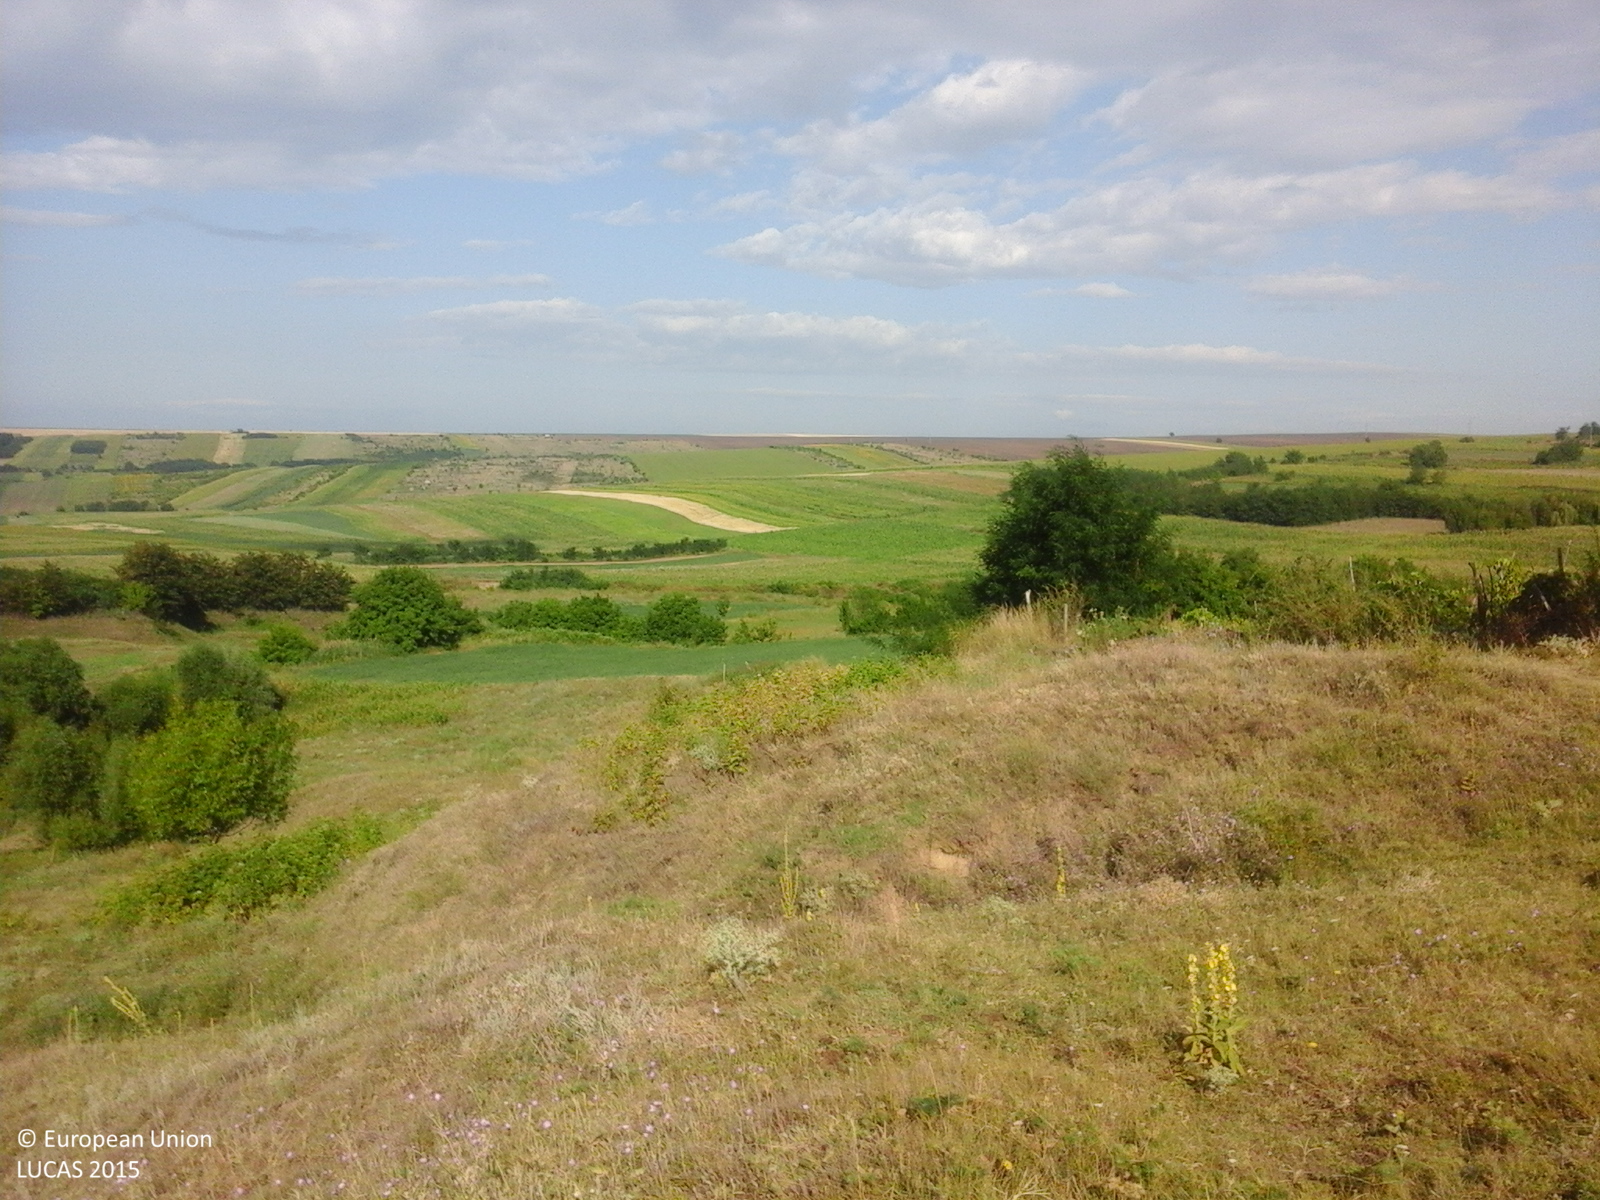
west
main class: Grassland
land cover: Grassland without tree/shrub cover
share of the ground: > 75 %
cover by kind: herbaceous plants 100 %
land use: Agriculture (excluding fallow land and kitchen gardens)
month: July
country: RO
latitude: 46.1567
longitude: 27.7657
